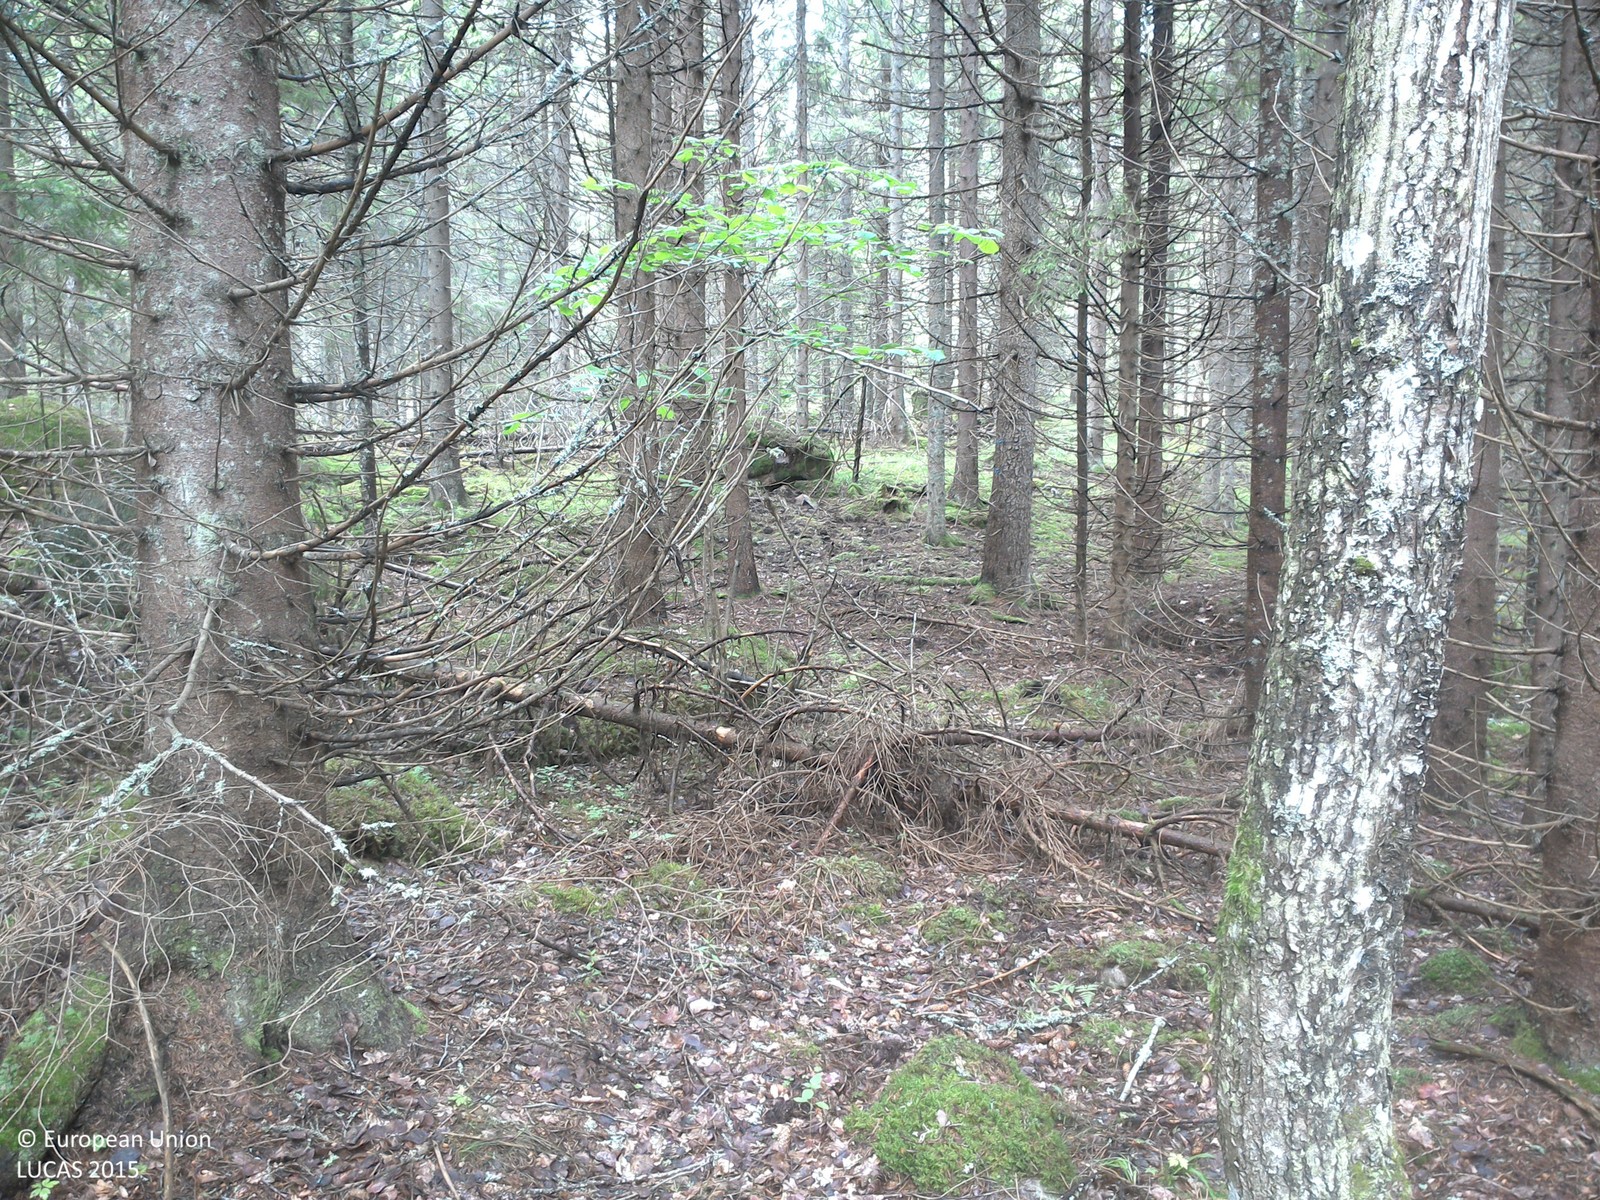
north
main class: Woodland
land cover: Spruce dominated coniferous woodland
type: boreal forest
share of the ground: > 75 %
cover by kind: coniferous forest trees 75 %, lichens and mosses 25 %
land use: Forestry
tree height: > 5 m
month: June
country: SE
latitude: 58.0859
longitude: 15.5752
